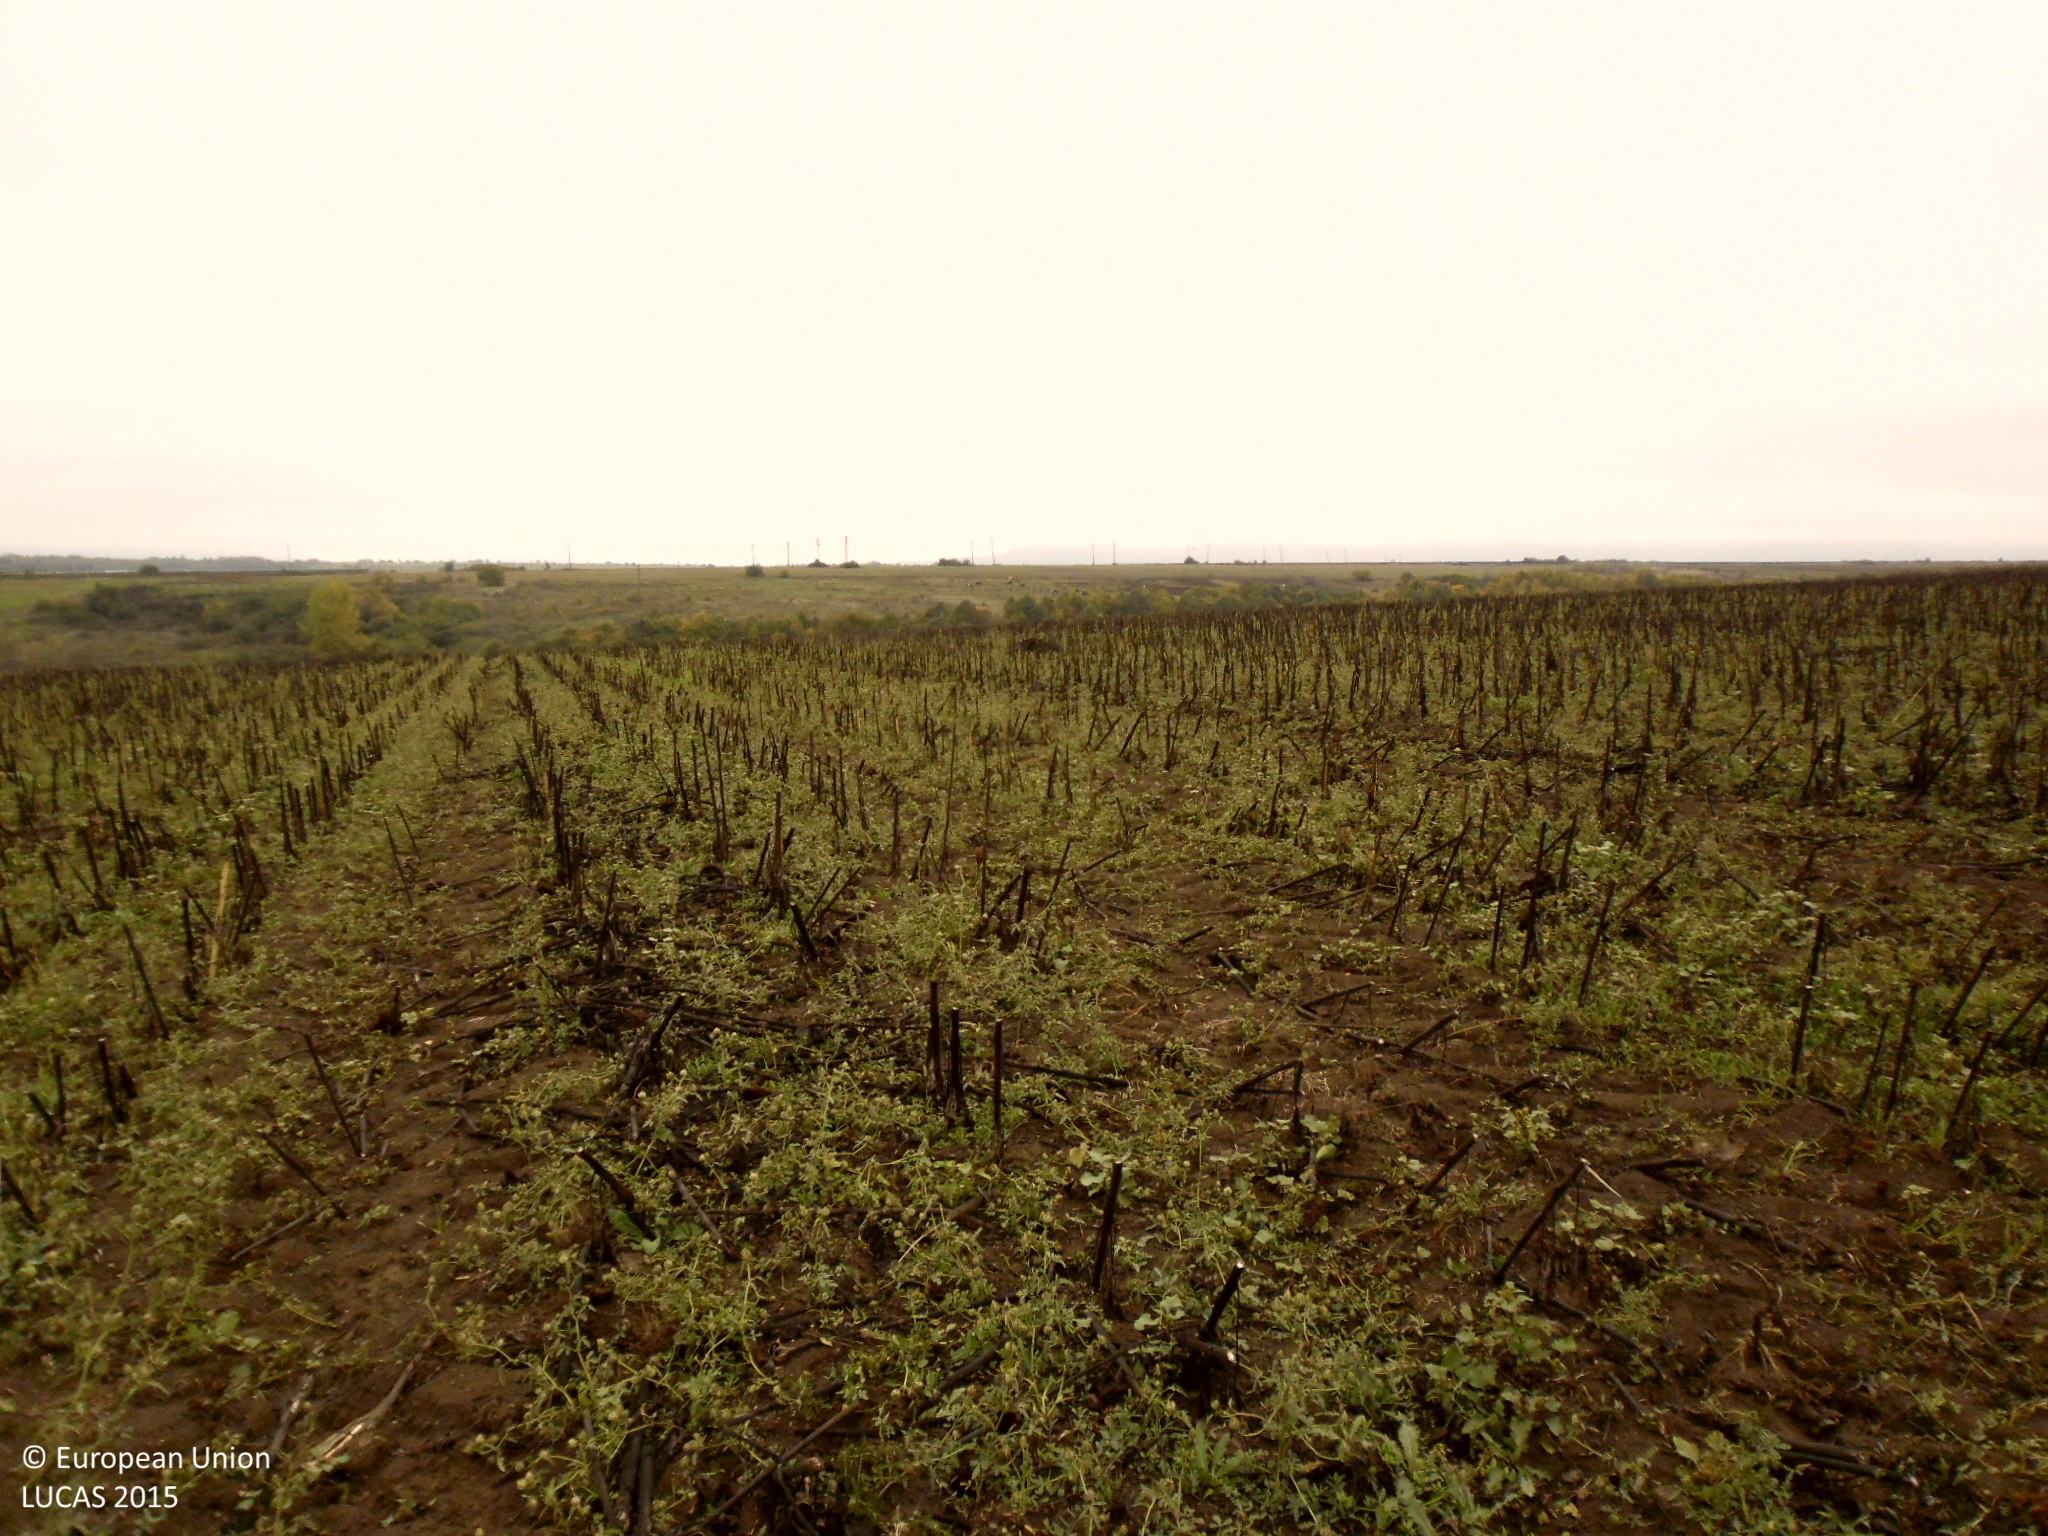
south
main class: Cropland
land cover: Sunflower
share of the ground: 10 - 25 %
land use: Agriculture (excluding fallow land and kitchen gardens)
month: October
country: BG
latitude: 43.6788
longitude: 22.8249
